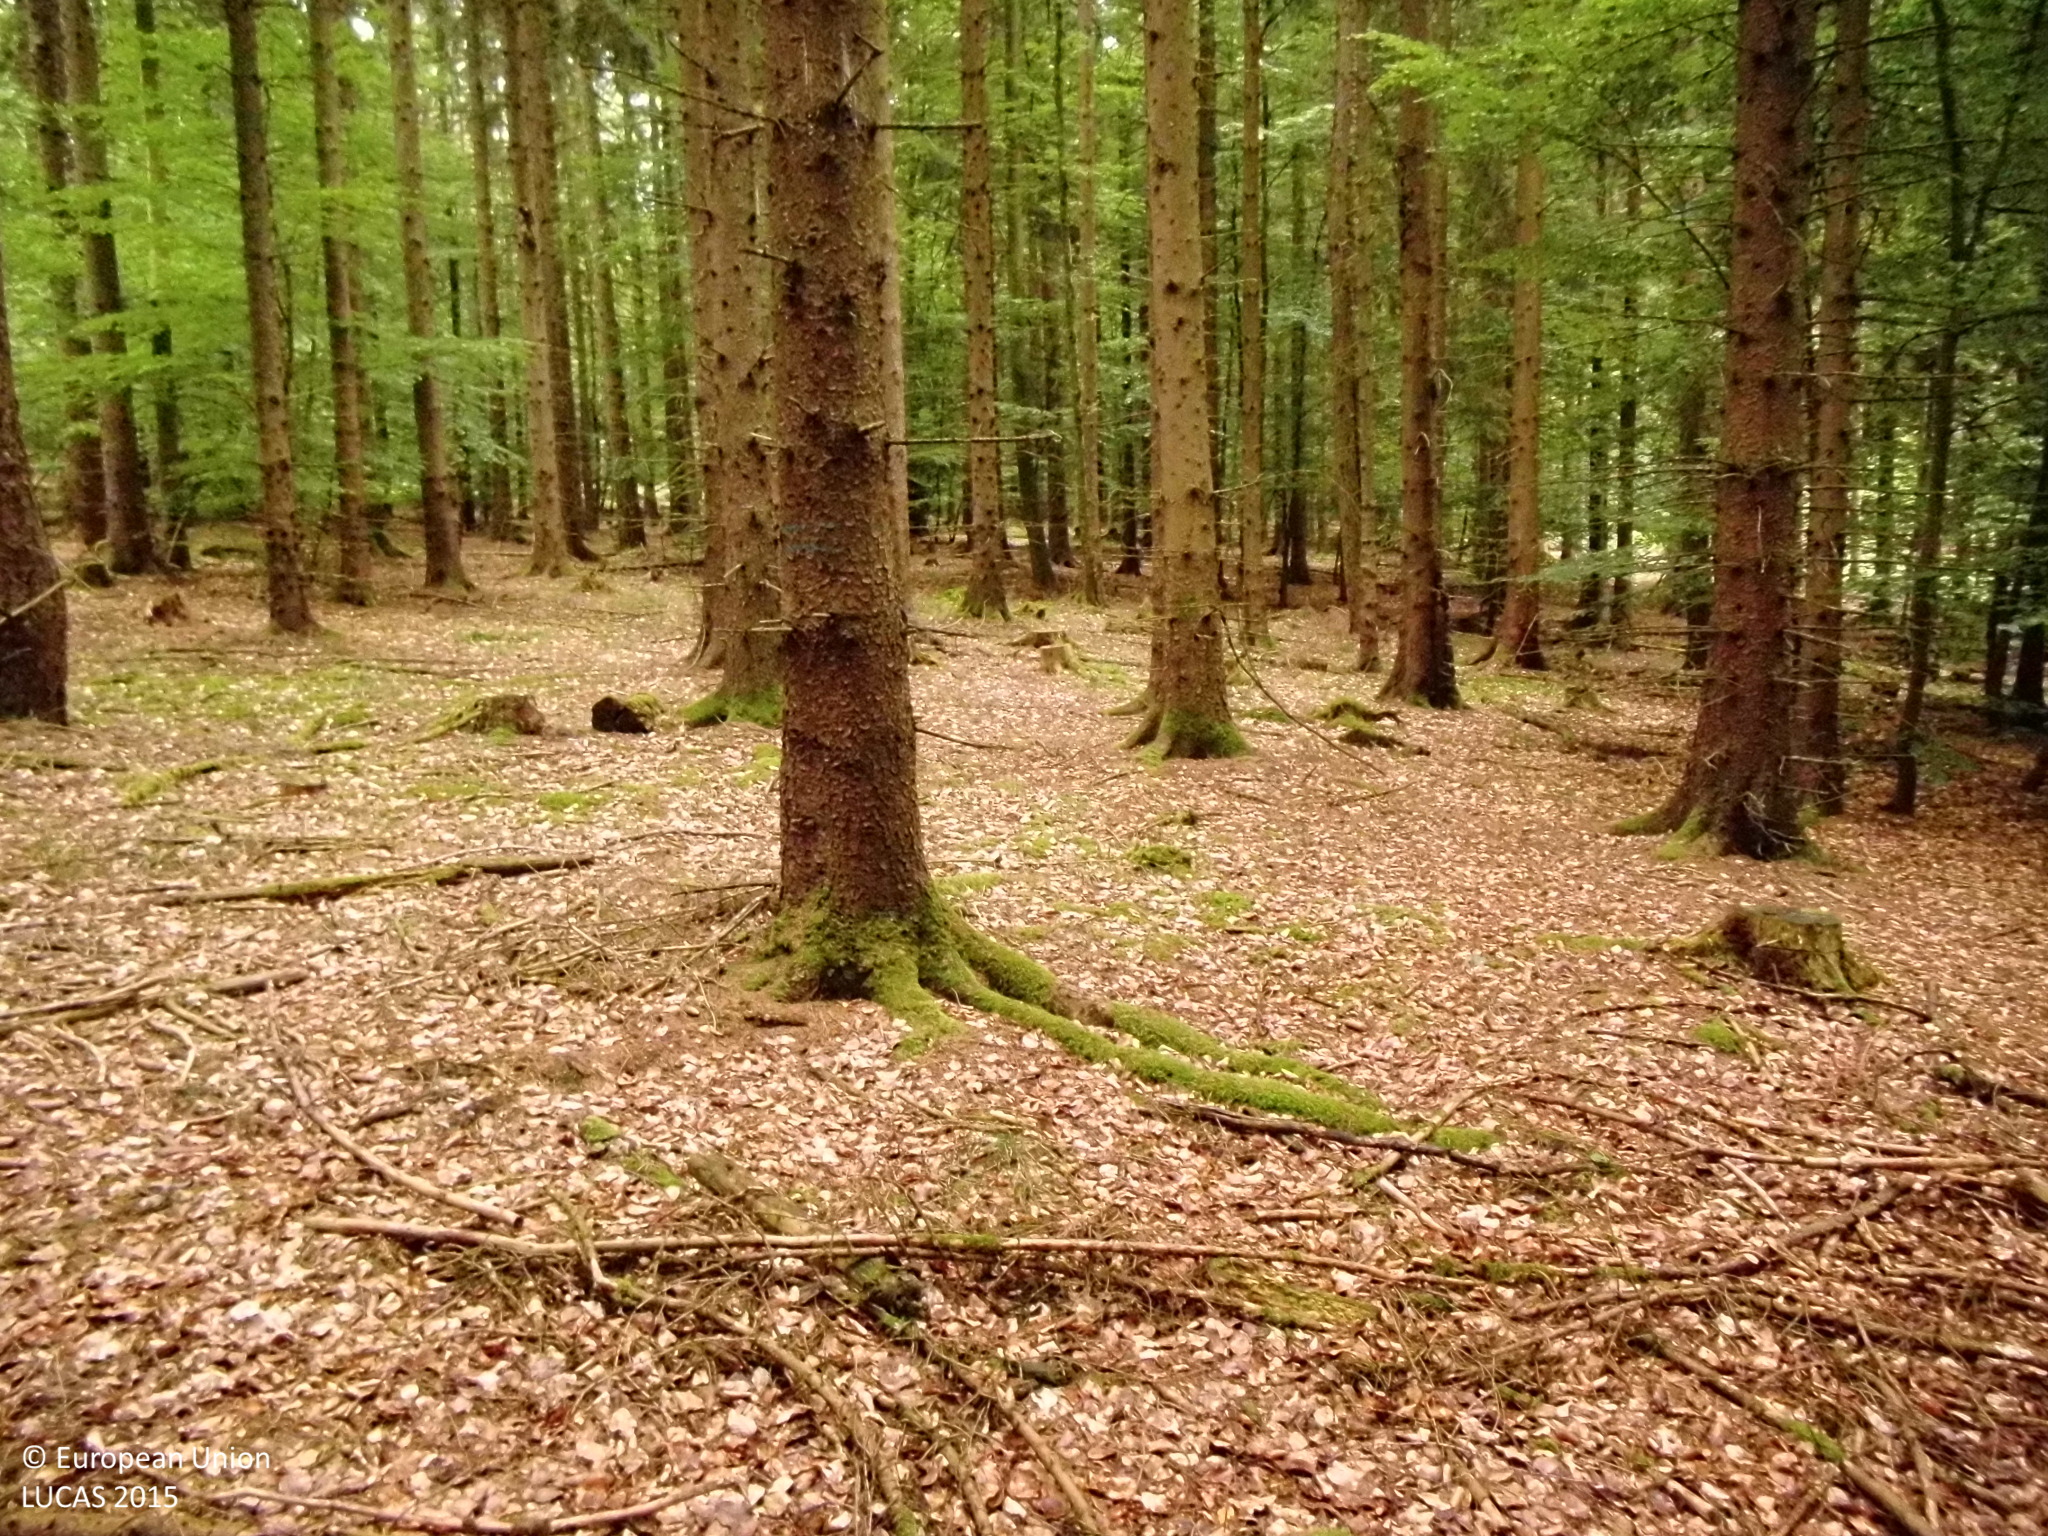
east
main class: Woodland
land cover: Spruce dominated mixed woodland
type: hemiboreal forest and nemoral coniferous forest and mixed broadleaved-coniferous forest
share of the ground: > 75 %
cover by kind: coniferous forest trees 60 %, broadleaved forest trees 35 %, unconsolidated bare surface 5 %
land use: Forestry
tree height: > 5 m
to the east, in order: Spruce dominated mixed woodland; Broadleaved woodland; Spruce dominated mixed woodland
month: July
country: DE
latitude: 50.4077
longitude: 8.4667
